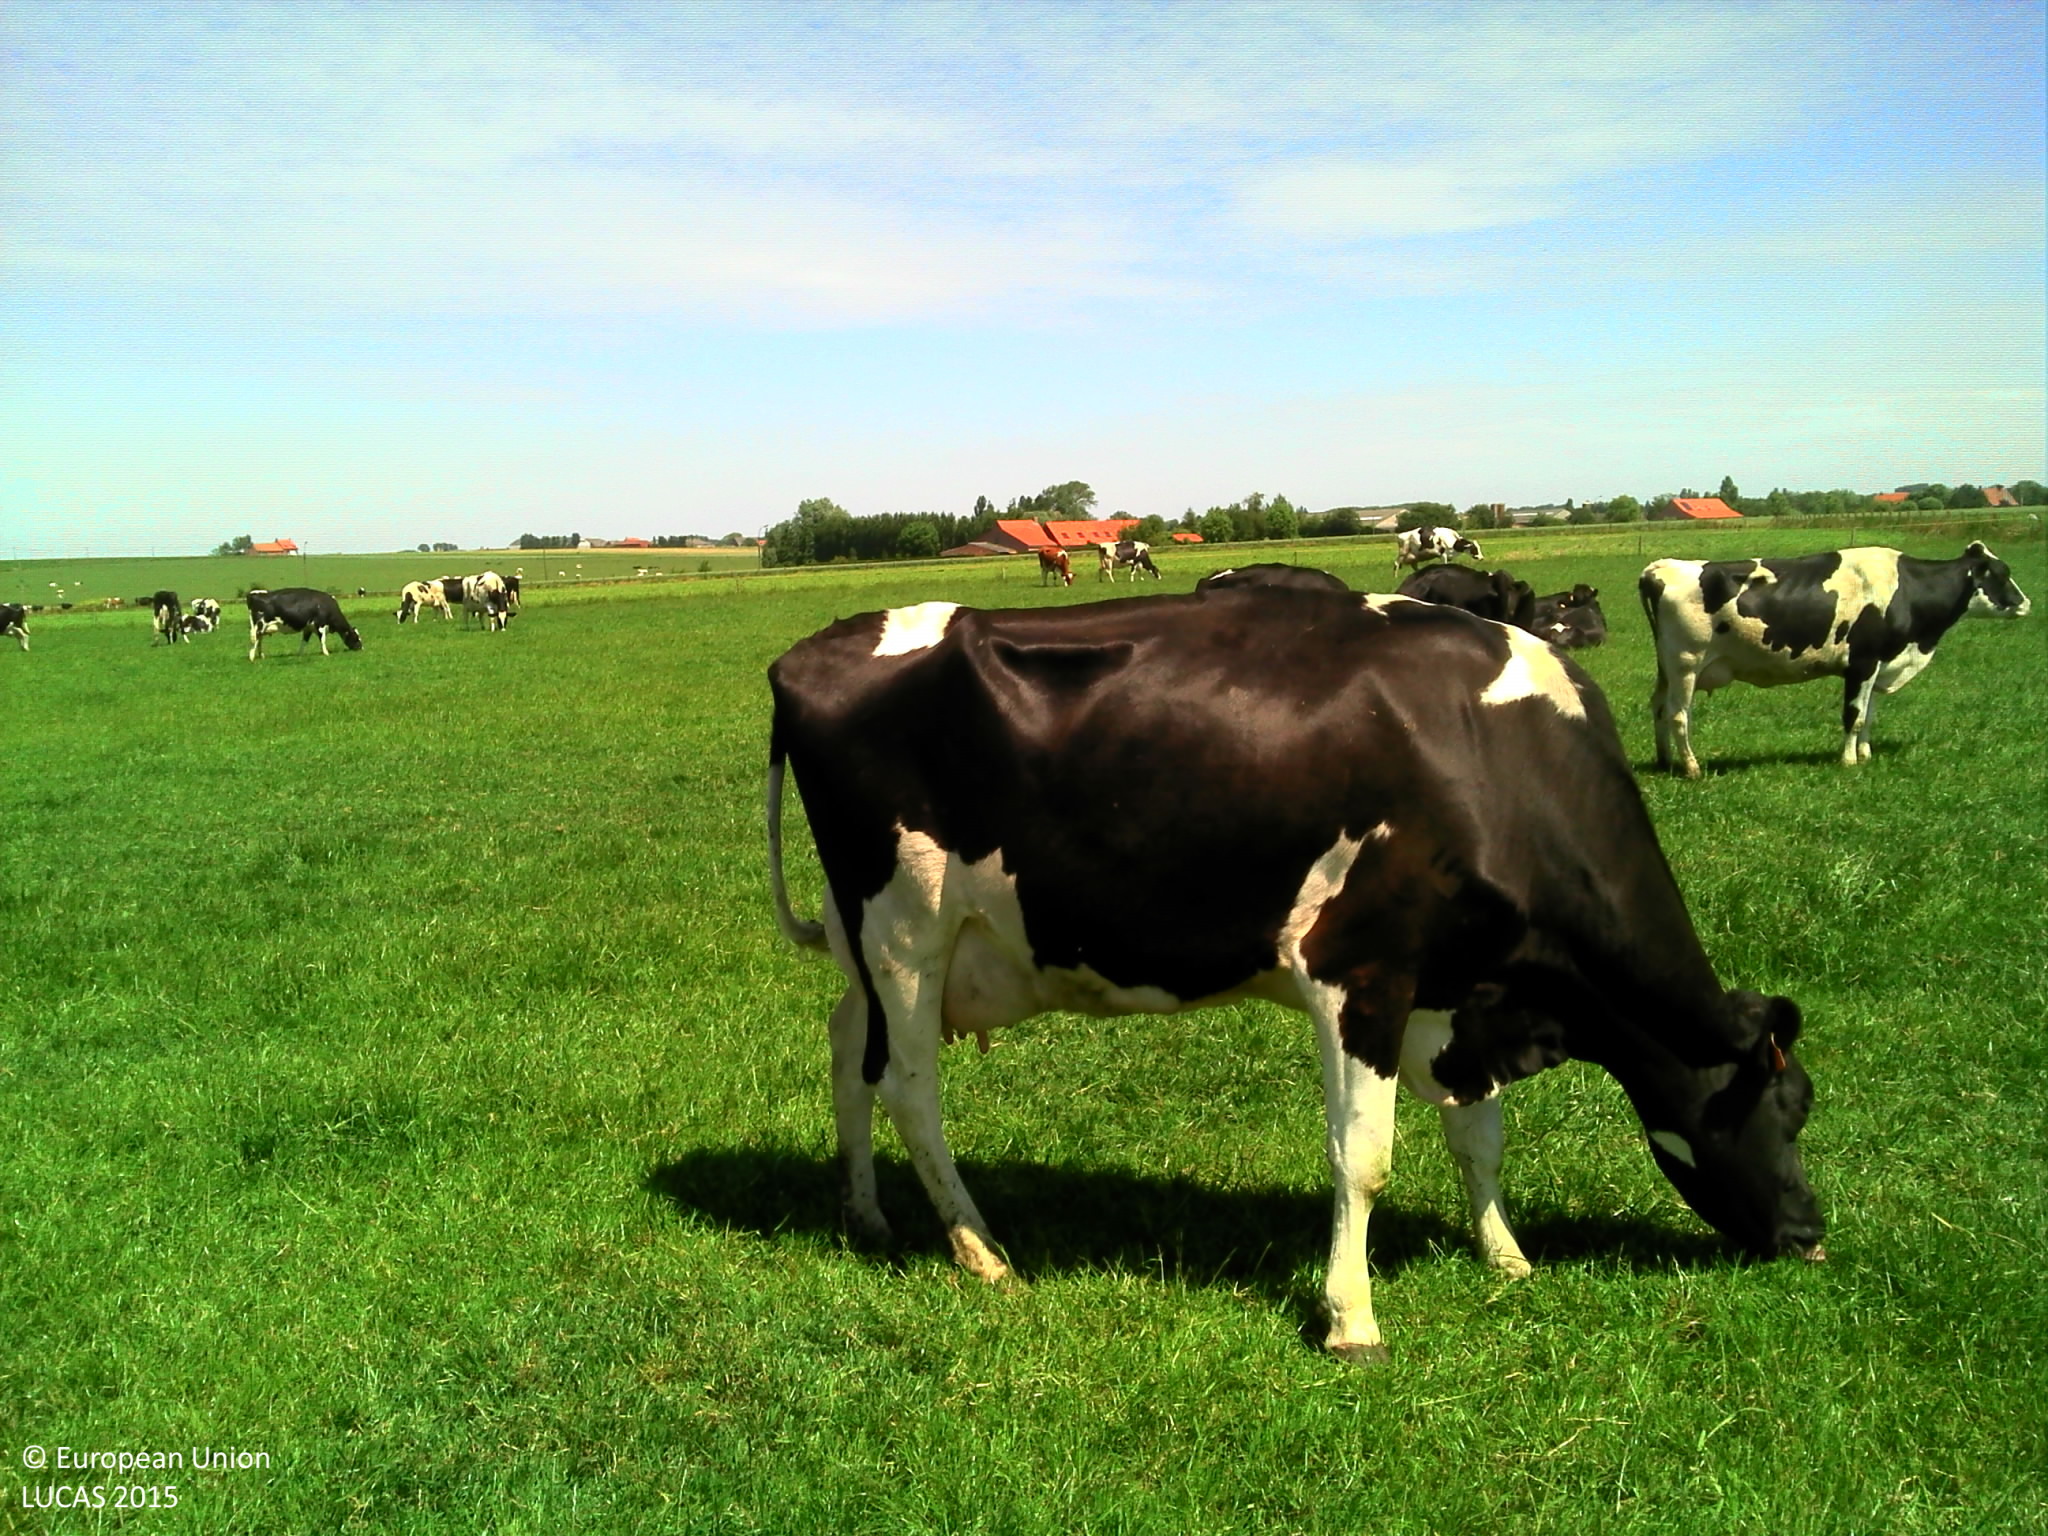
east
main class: Grassland
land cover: Grassland without tree/shrub cover
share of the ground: > 75 %
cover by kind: herbaceous plants 100 %
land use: Agriculture (excluding fallow land and kitchen gardens)
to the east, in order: Grassland without tree/shrub cover; Fences; Sugar beet; Fences; Grass margins; Common wheat
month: June
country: BE
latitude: 50.8867
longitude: 2.9532
